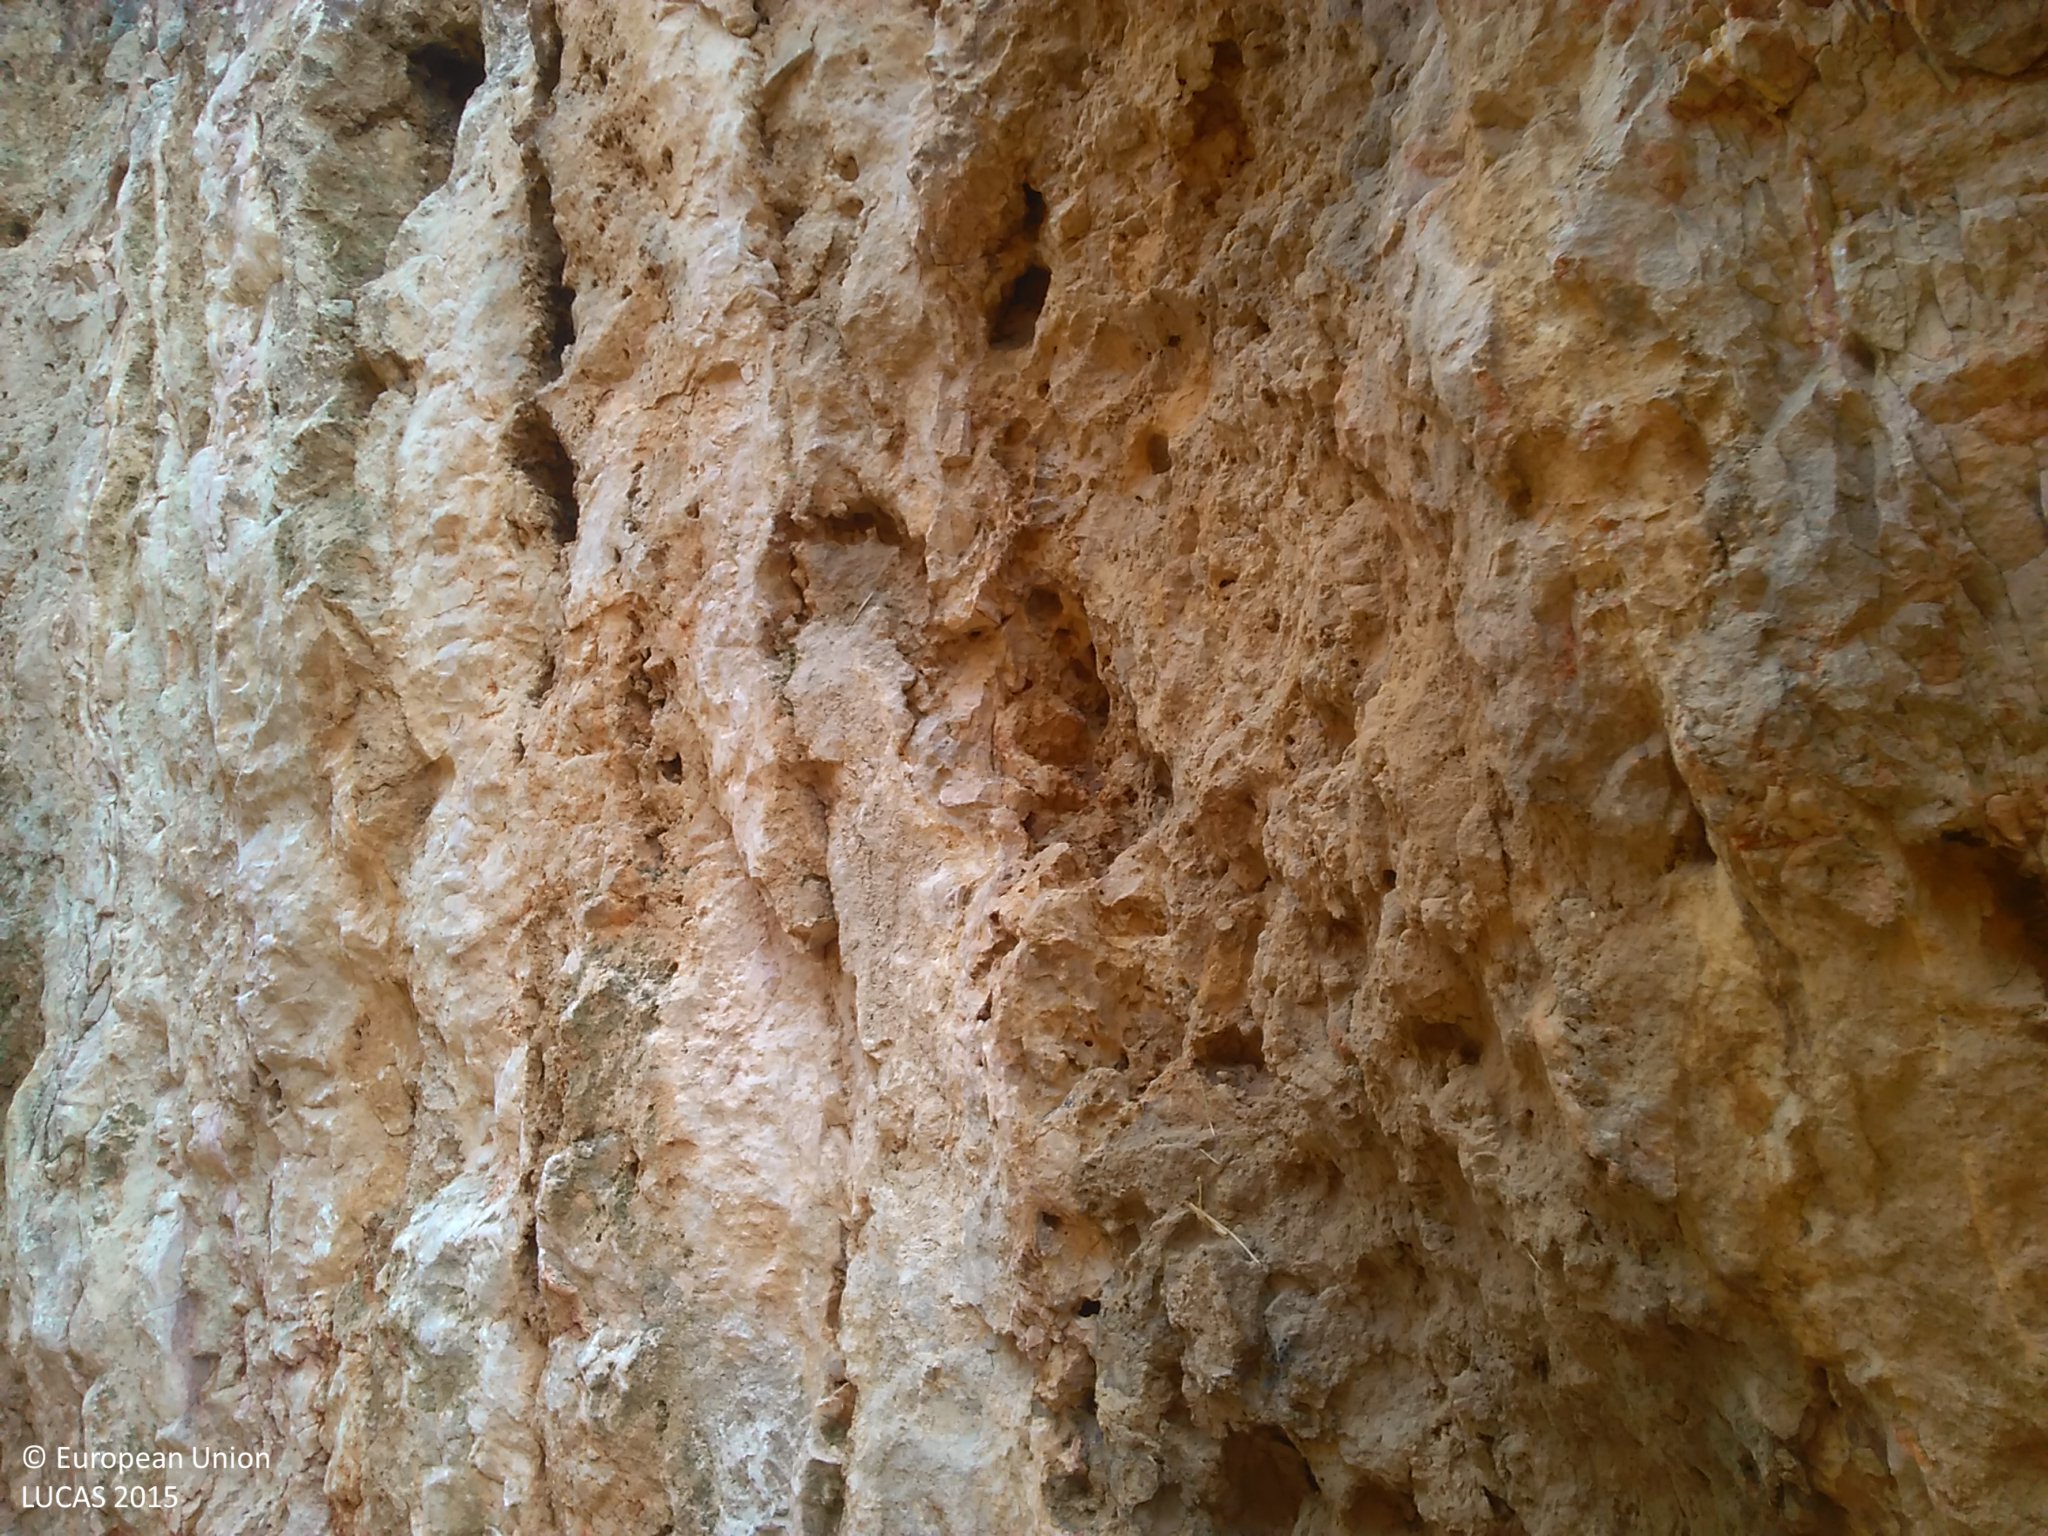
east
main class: Woodland
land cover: Broadleaved woodland
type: broadleaved evergreen forest
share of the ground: 50 - 75 %
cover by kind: broadleaved forest trees 50 %, unconsolidated bare surface 30 %, shrubs 10 %, herbaceous plants 10 %
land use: Semi-natural and natural areas not in use
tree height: < 5 m
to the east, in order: Broadleaved woodland
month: July
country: ES
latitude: 41.3606
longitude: -1.9462
